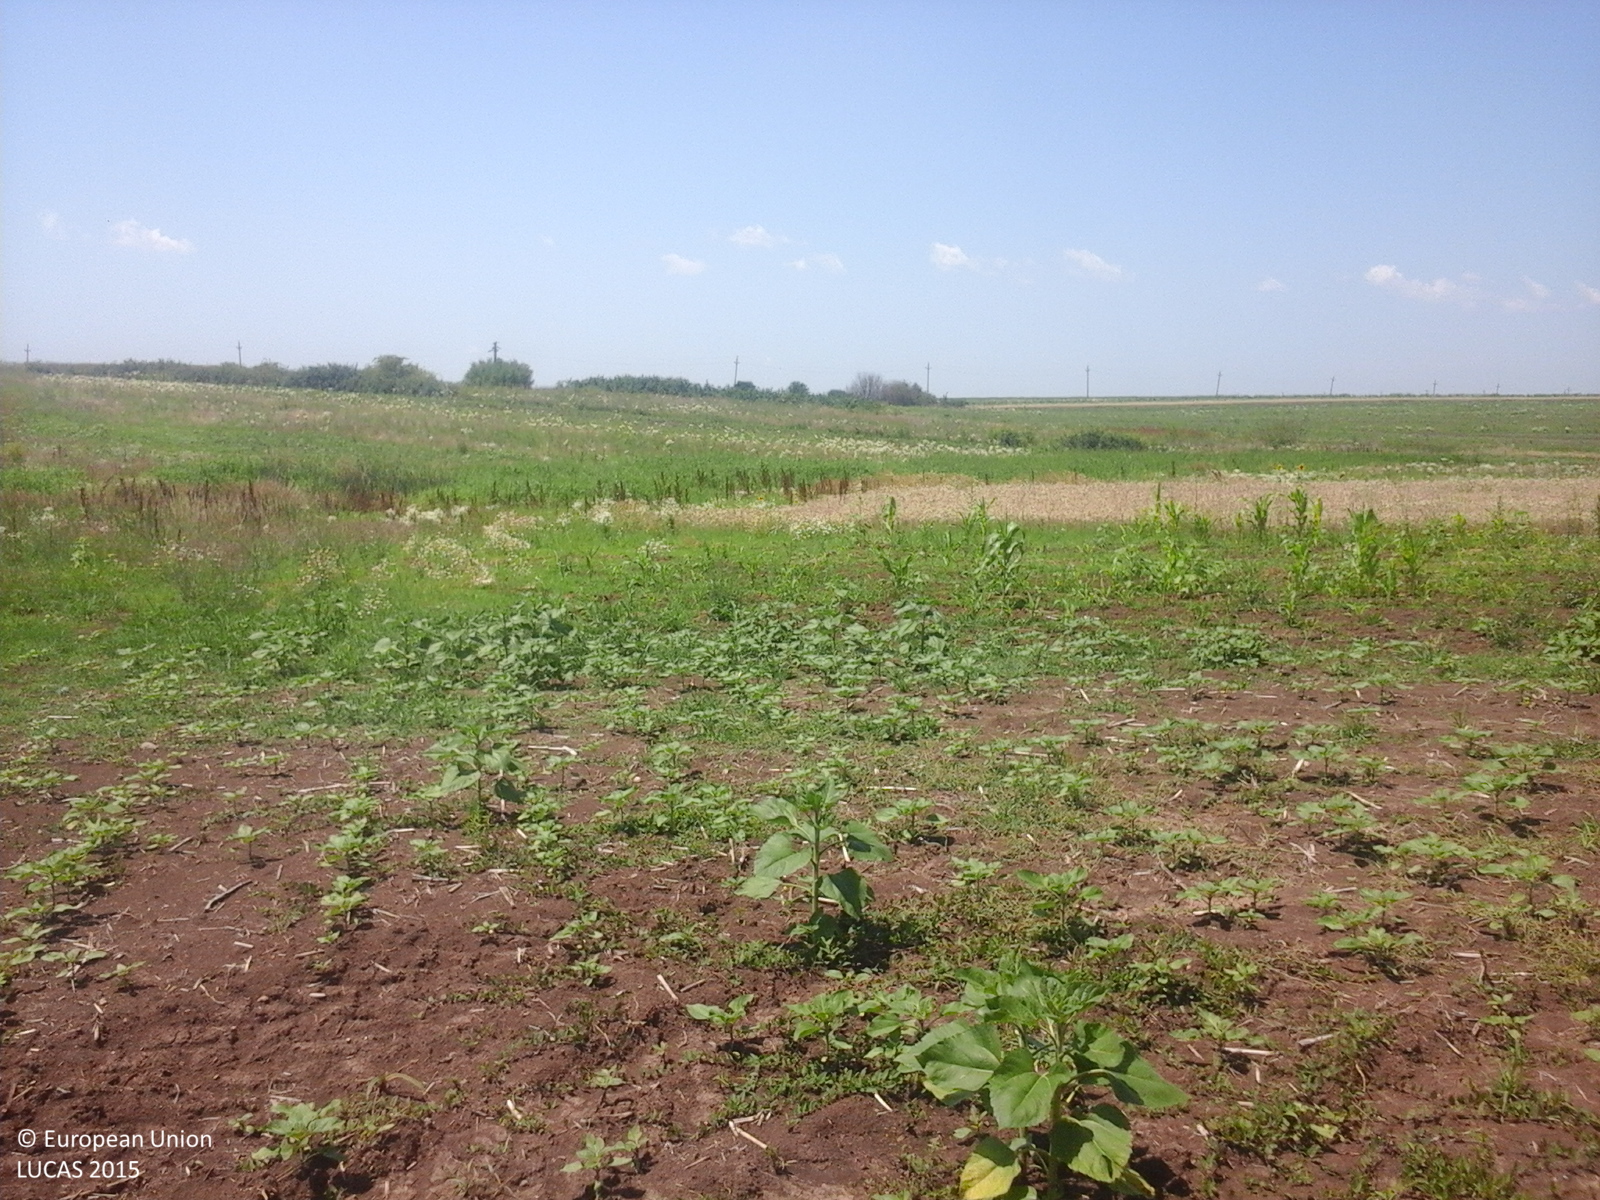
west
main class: Cropland
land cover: Sunflower
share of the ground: < 10 %
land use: Agriculture (excluding fallow land and kitchen gardens)
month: July
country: RO
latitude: 44.4342
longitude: 24.6847
